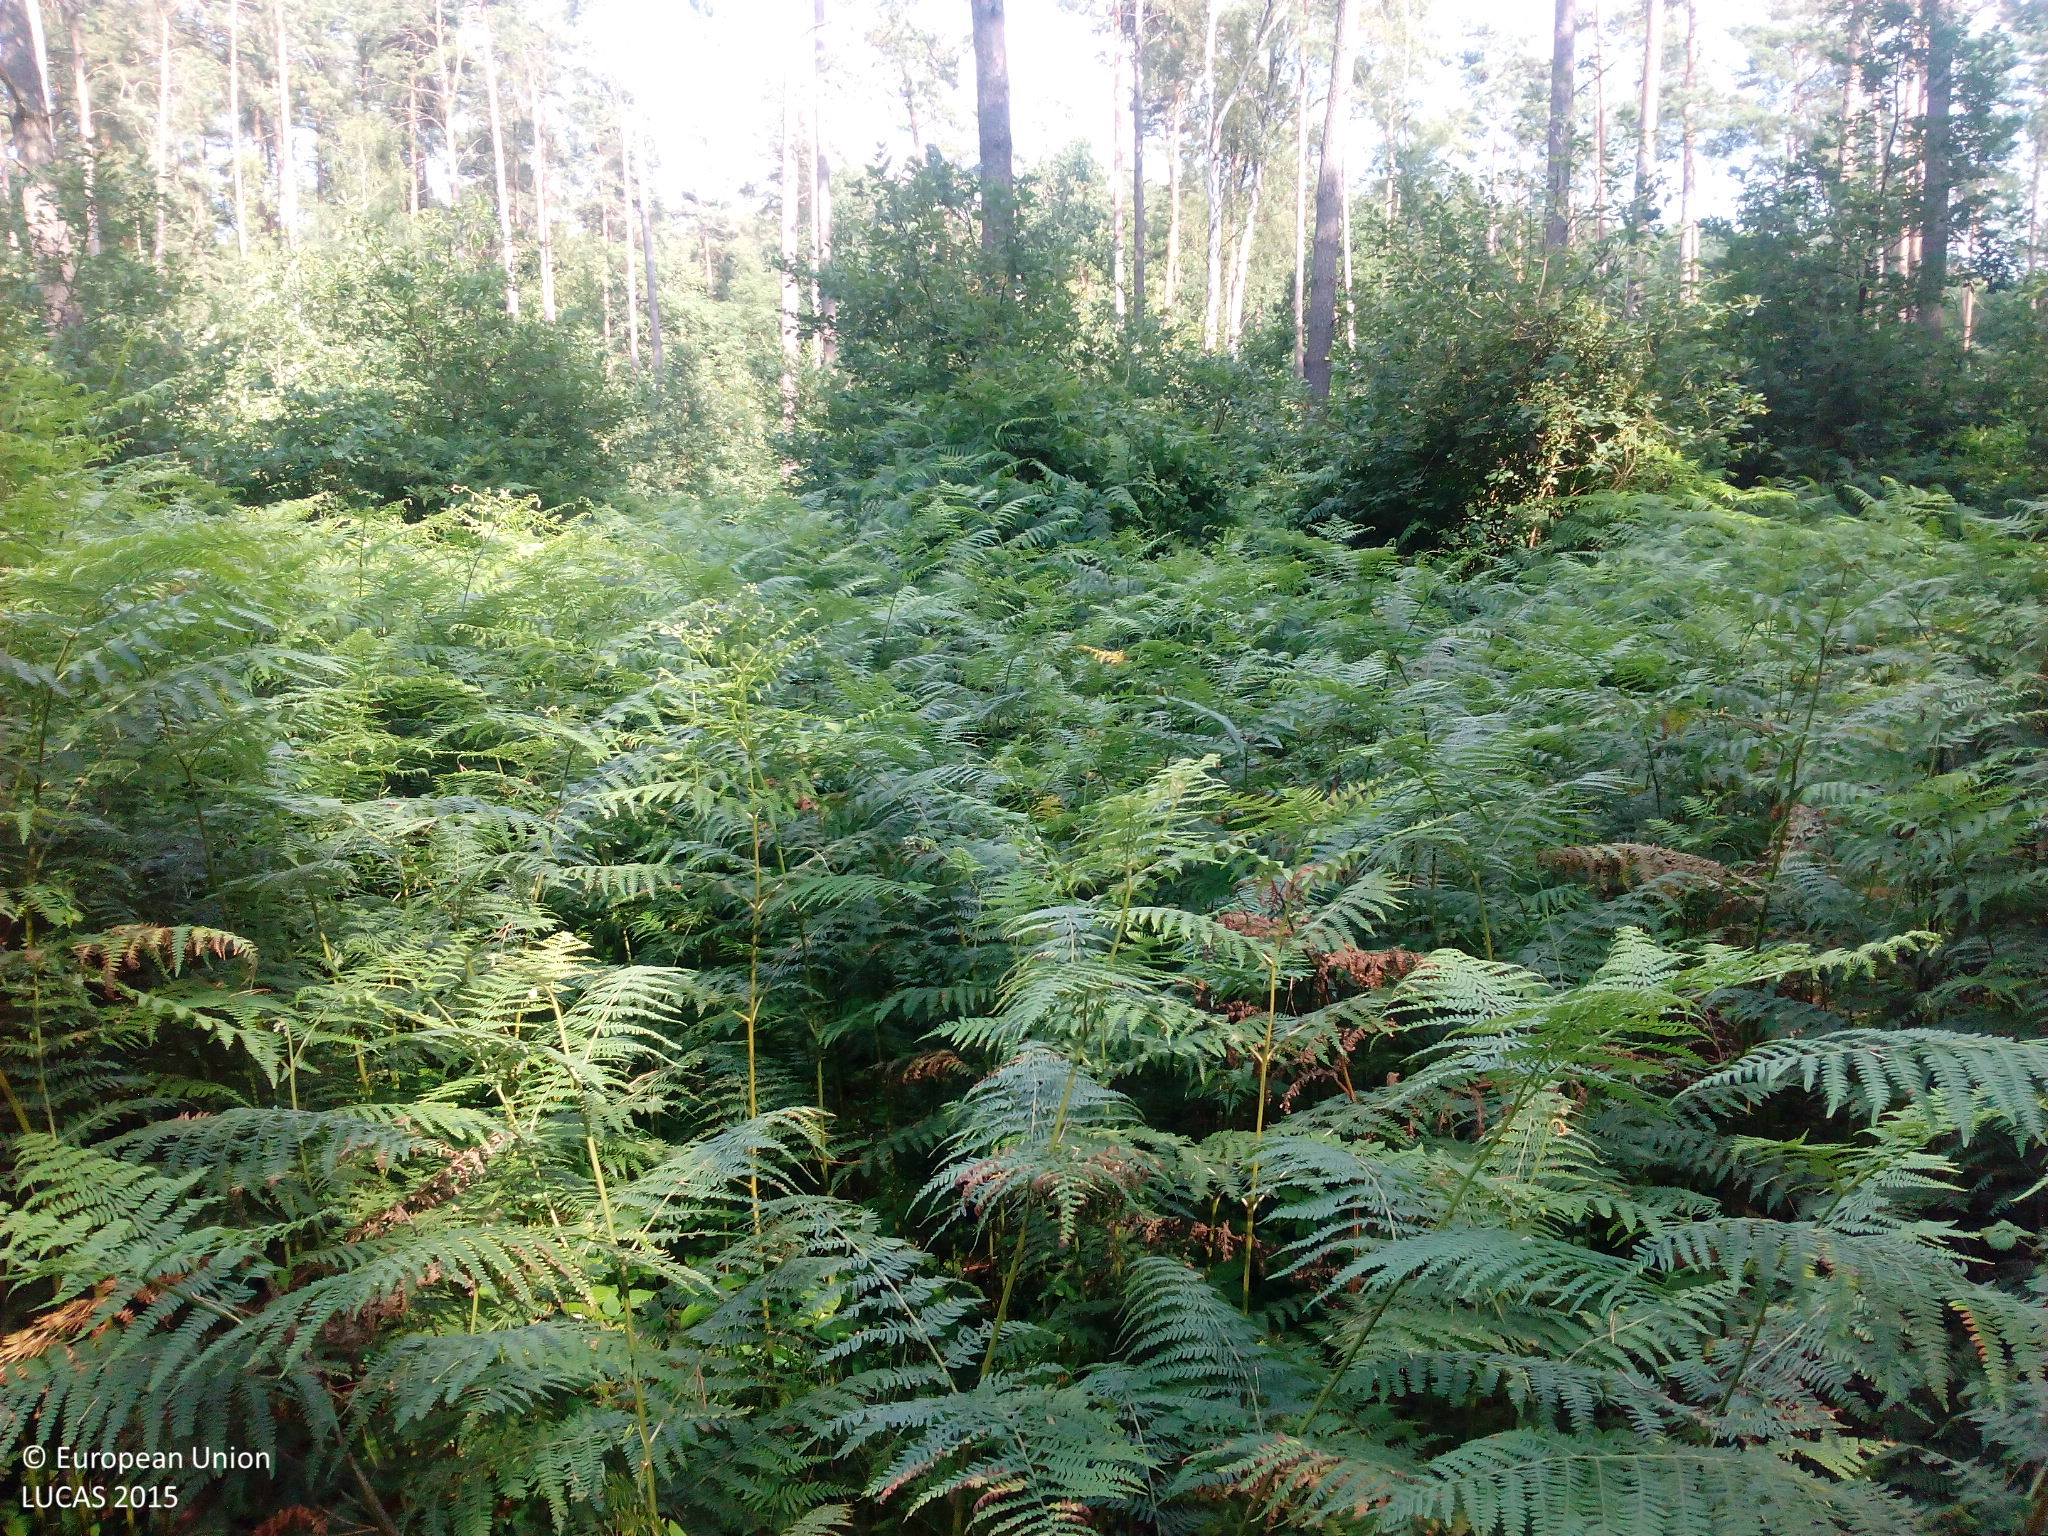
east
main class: Woodland
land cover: Pine dominated coniferous woodland
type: hemiboreal forest and nemoral coniferous forest and mixed broadleaved-coniferous forest
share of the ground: > 75 %
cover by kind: coniferous forest trees 95 %, herbaceous plants 5 %
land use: Forestry
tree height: > 5 m
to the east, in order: Pine dominated coniferous woodland; Broadleaved woodland; Paved roads, cycling and walking lanes; Broadleaved woodland; Rivers and streams; Broadleaved woodland
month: July
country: DE
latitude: 51.9366
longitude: 12.5451
